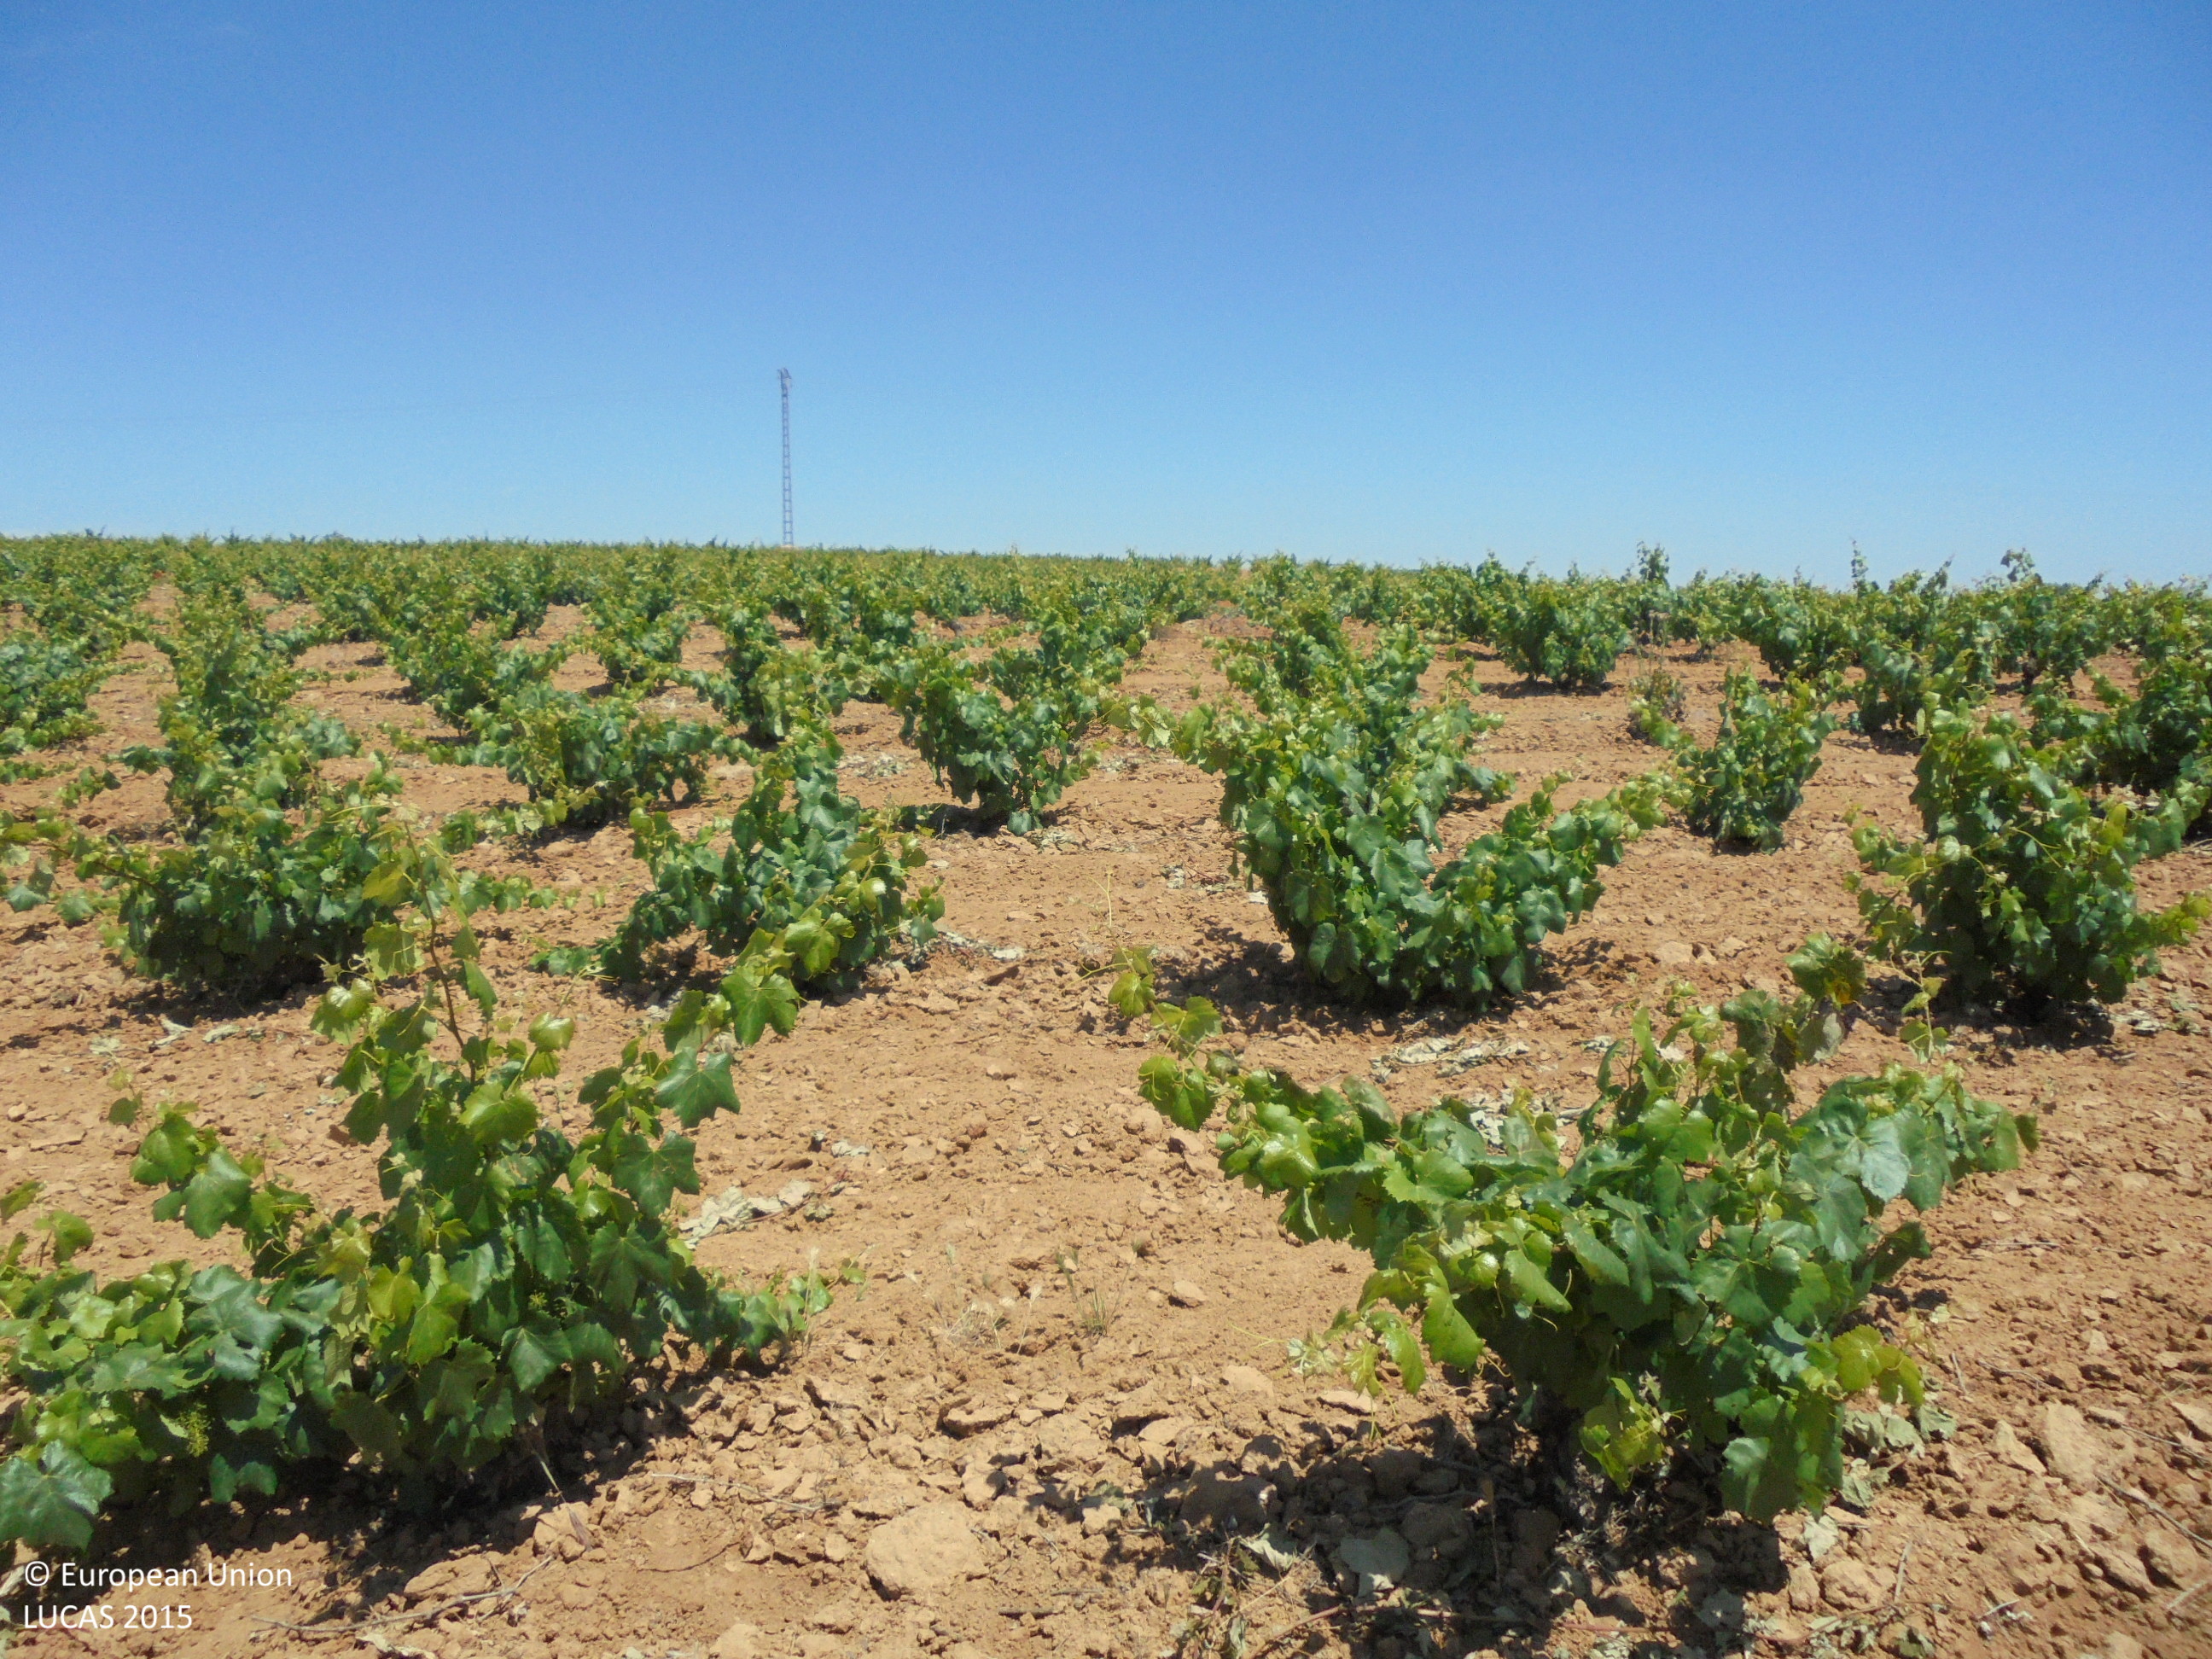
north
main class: Cropland
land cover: Vineyards
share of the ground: 25 - 50 %
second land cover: Other bare soil
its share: > 75 %
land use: Agriculture (excluding fallow land and kitchen gardens)
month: June
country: ES
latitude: 38.8309
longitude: -1.5734
